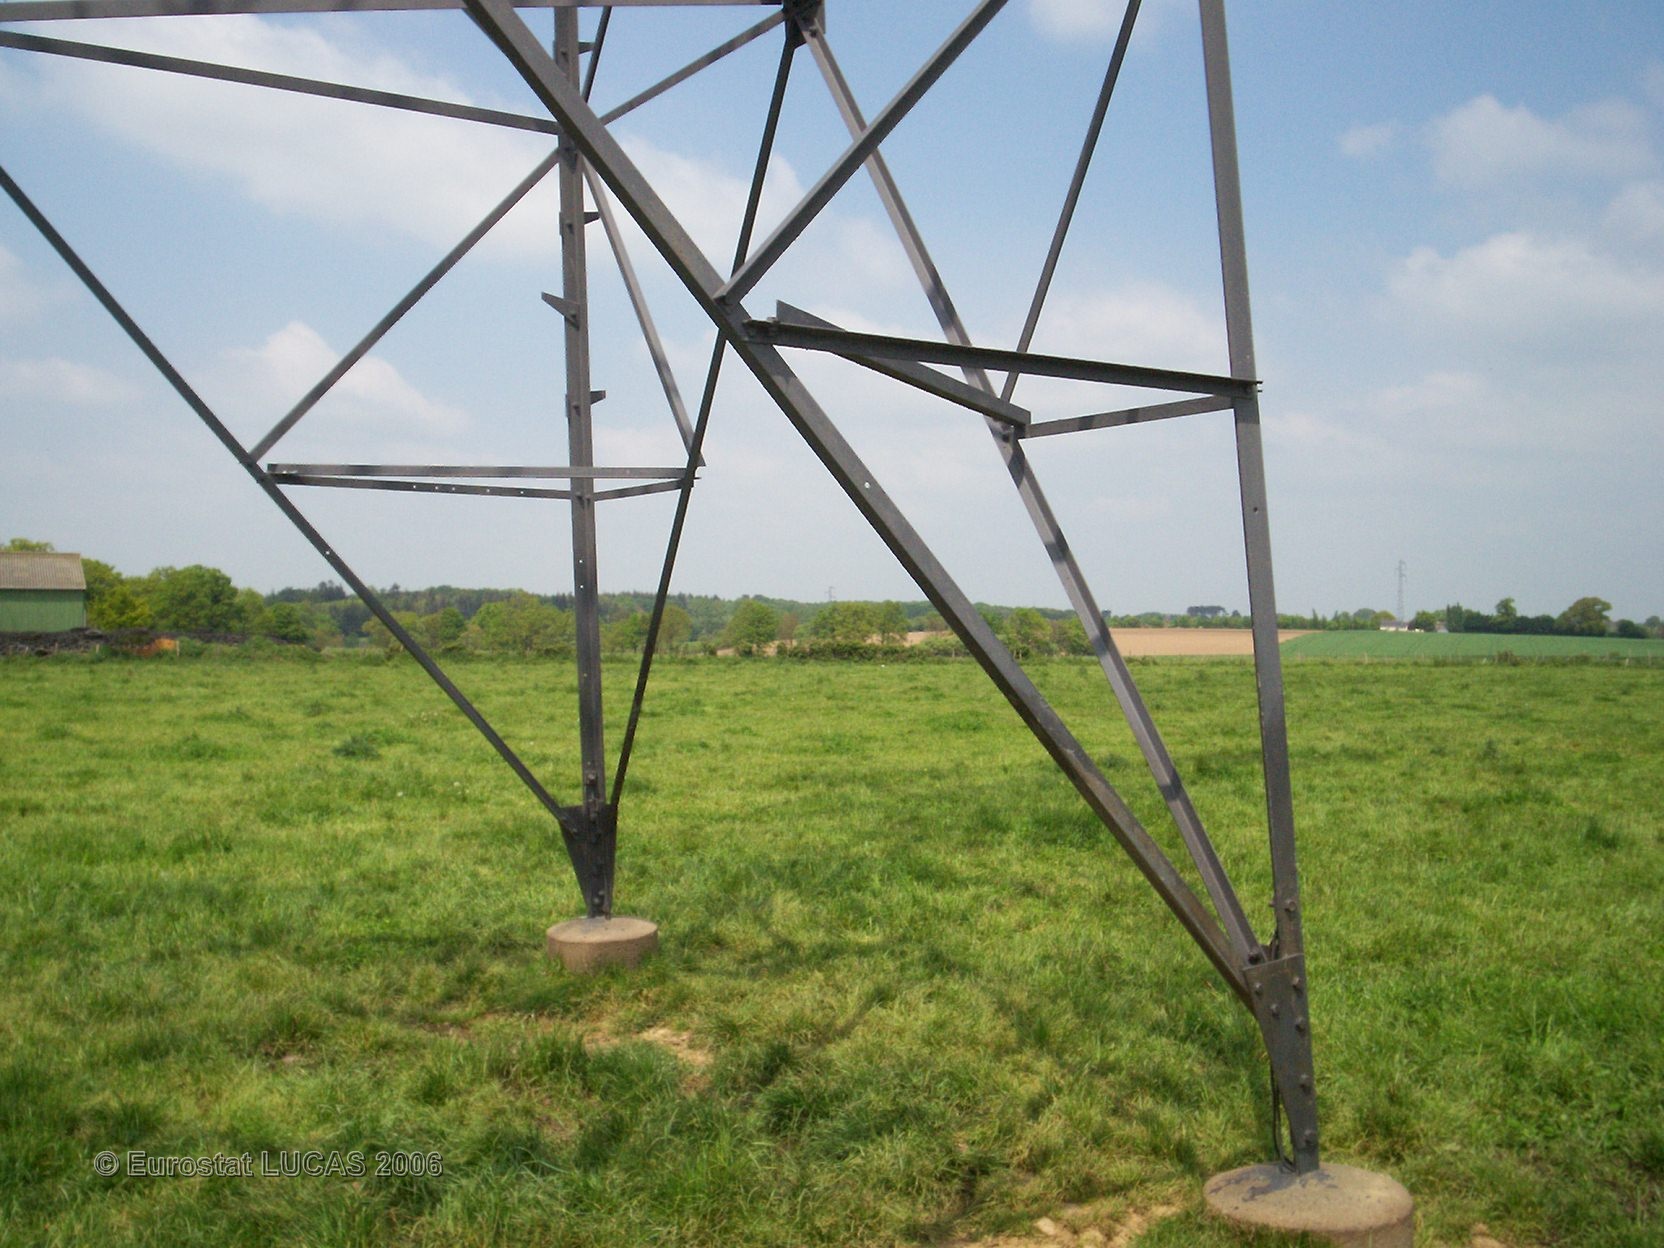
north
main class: Grassland
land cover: Grassland without tree/shrub cover
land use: Agriculture (excluding fallow land and kitchen gardens)
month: May
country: FR
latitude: 47.5390
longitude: -2.2356
